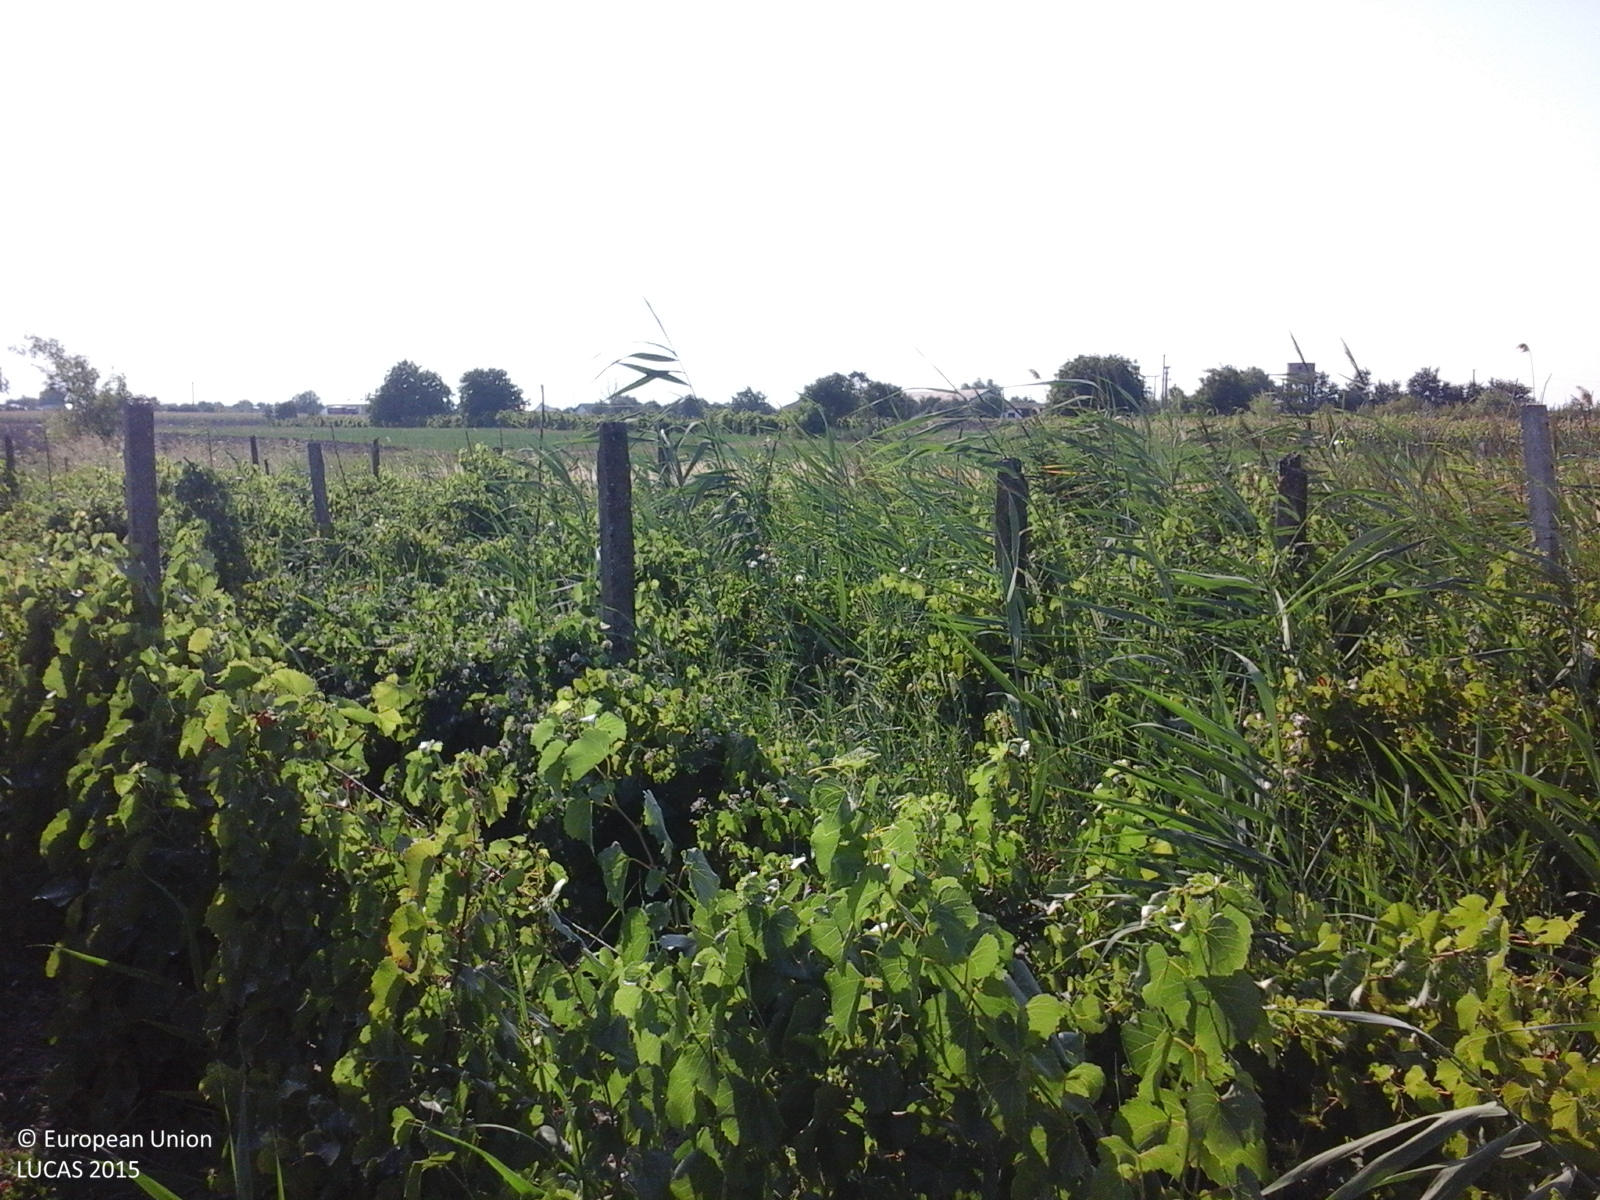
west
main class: Cropland
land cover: Vineyards
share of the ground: > 75 %
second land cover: Other bare soil
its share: > 75 %
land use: Agriculture (excluding fallow land and kitchen gardens)
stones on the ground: < 10 %
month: August
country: RO
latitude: 45.5548
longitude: 27.5121
